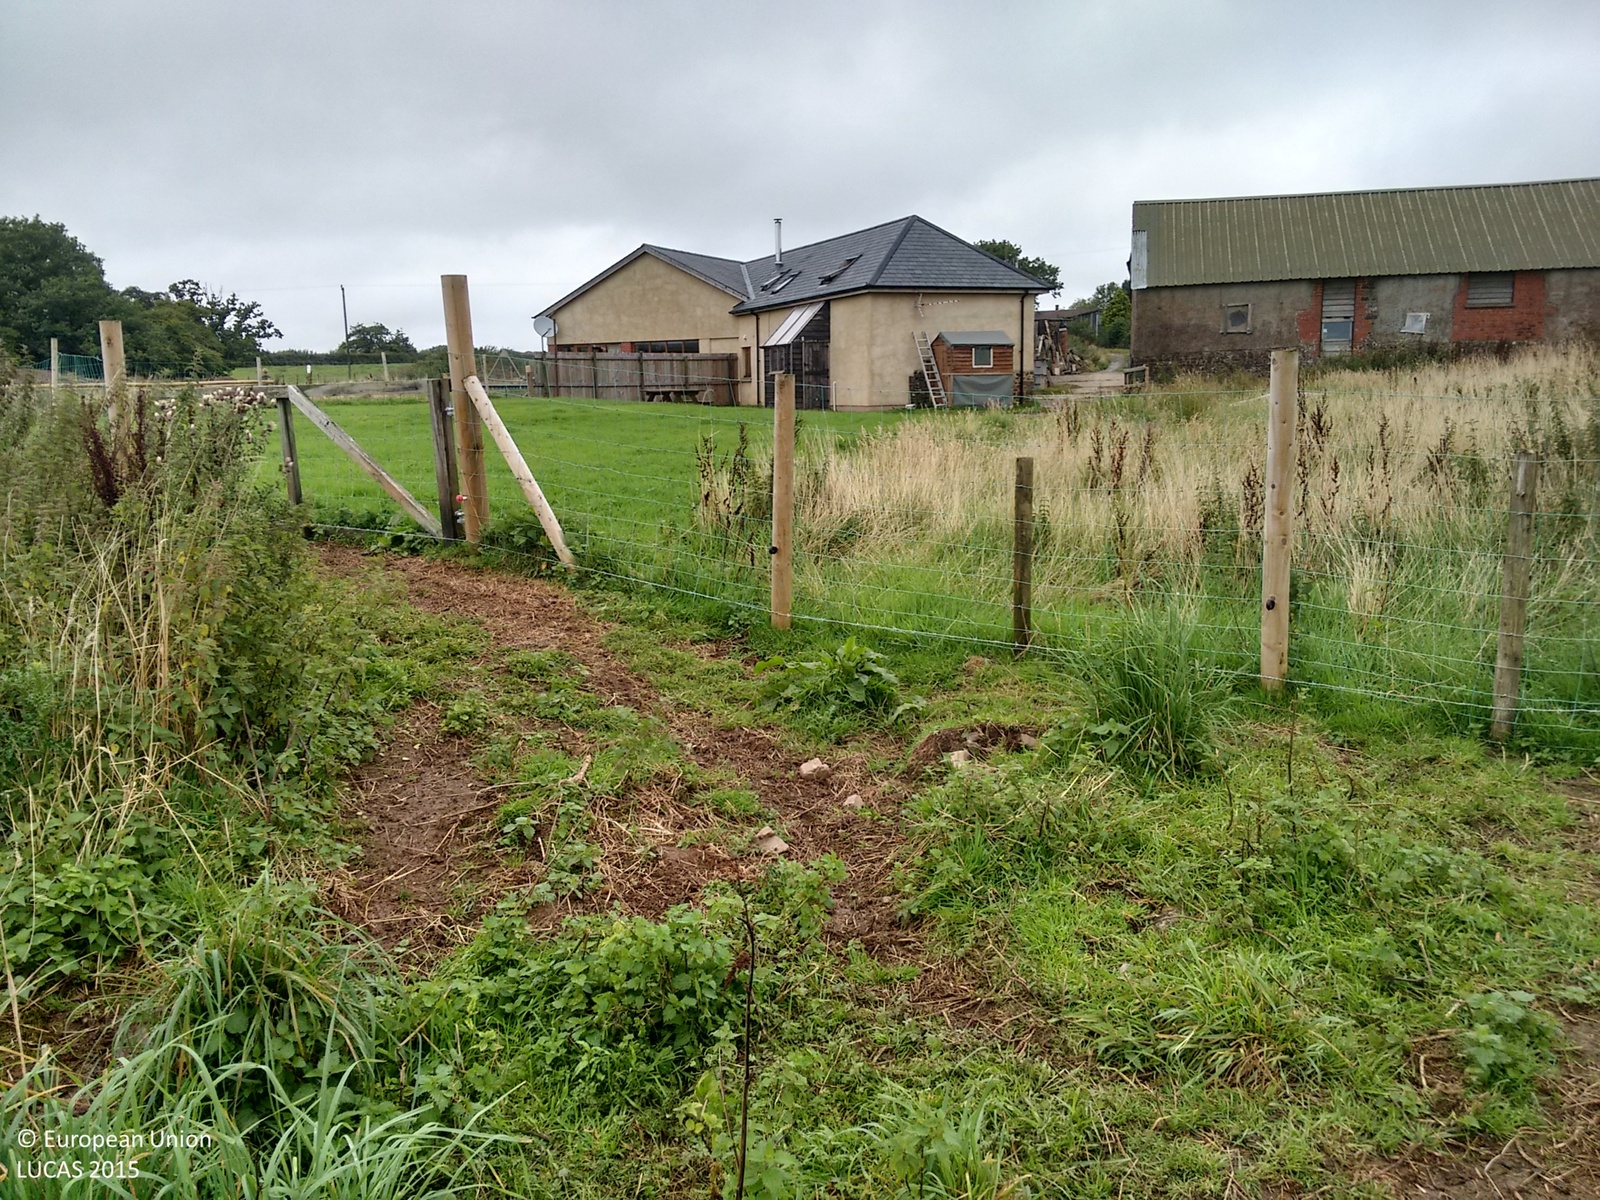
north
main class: Grassland
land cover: Spontaneously vegetated surfaces
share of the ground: > 75 %
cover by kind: herbaceous plants 100 %
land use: Agriculture (excluding fallow land and kitchen gardens)
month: August
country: GB
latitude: 50.8925
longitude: -3.6354
